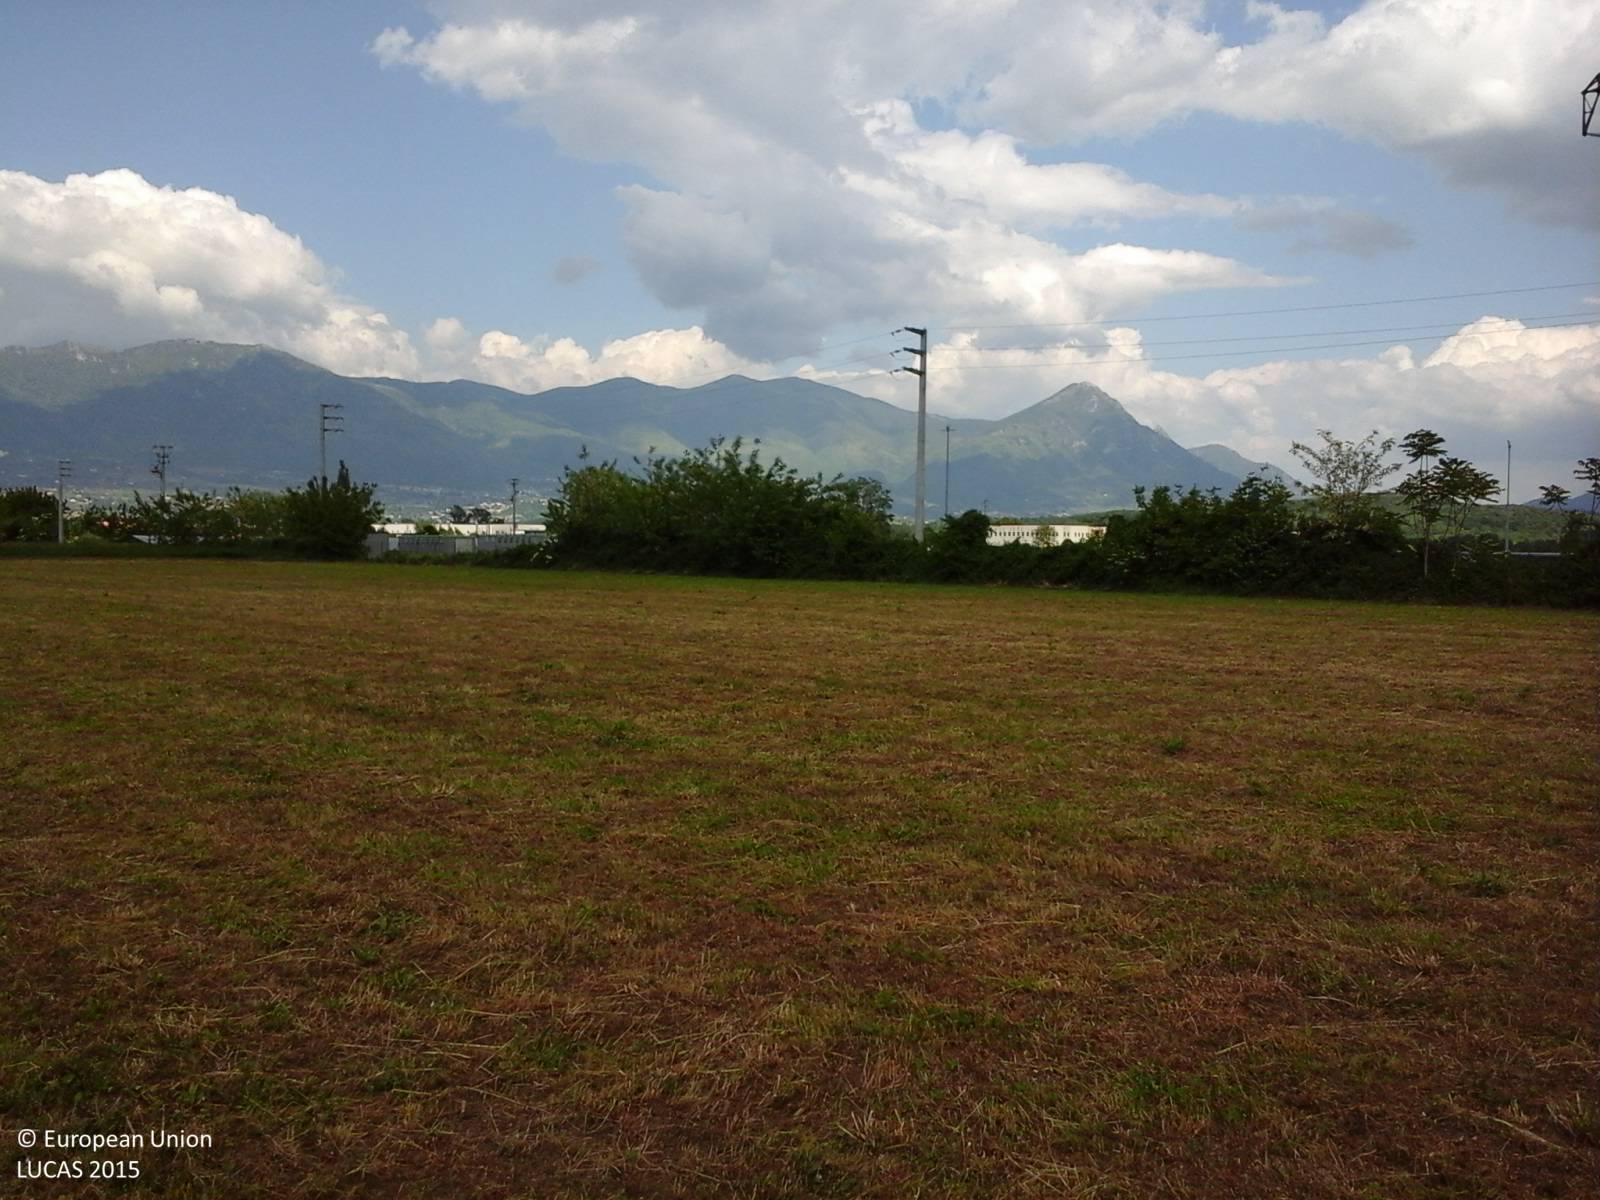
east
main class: Cropland
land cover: Temporary grasslands
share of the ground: 25 - 50 %
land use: Agriculture (excluding fallow land and kitchen gardens)
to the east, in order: Temporary grasslands; Electric lines; Temporary grasslands; Abandoned hedges; Electric lines; Tracks; Grass margins; Fences; Artificial constructions in urban areas
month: May
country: IT
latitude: 41.2943
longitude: 14.3423
